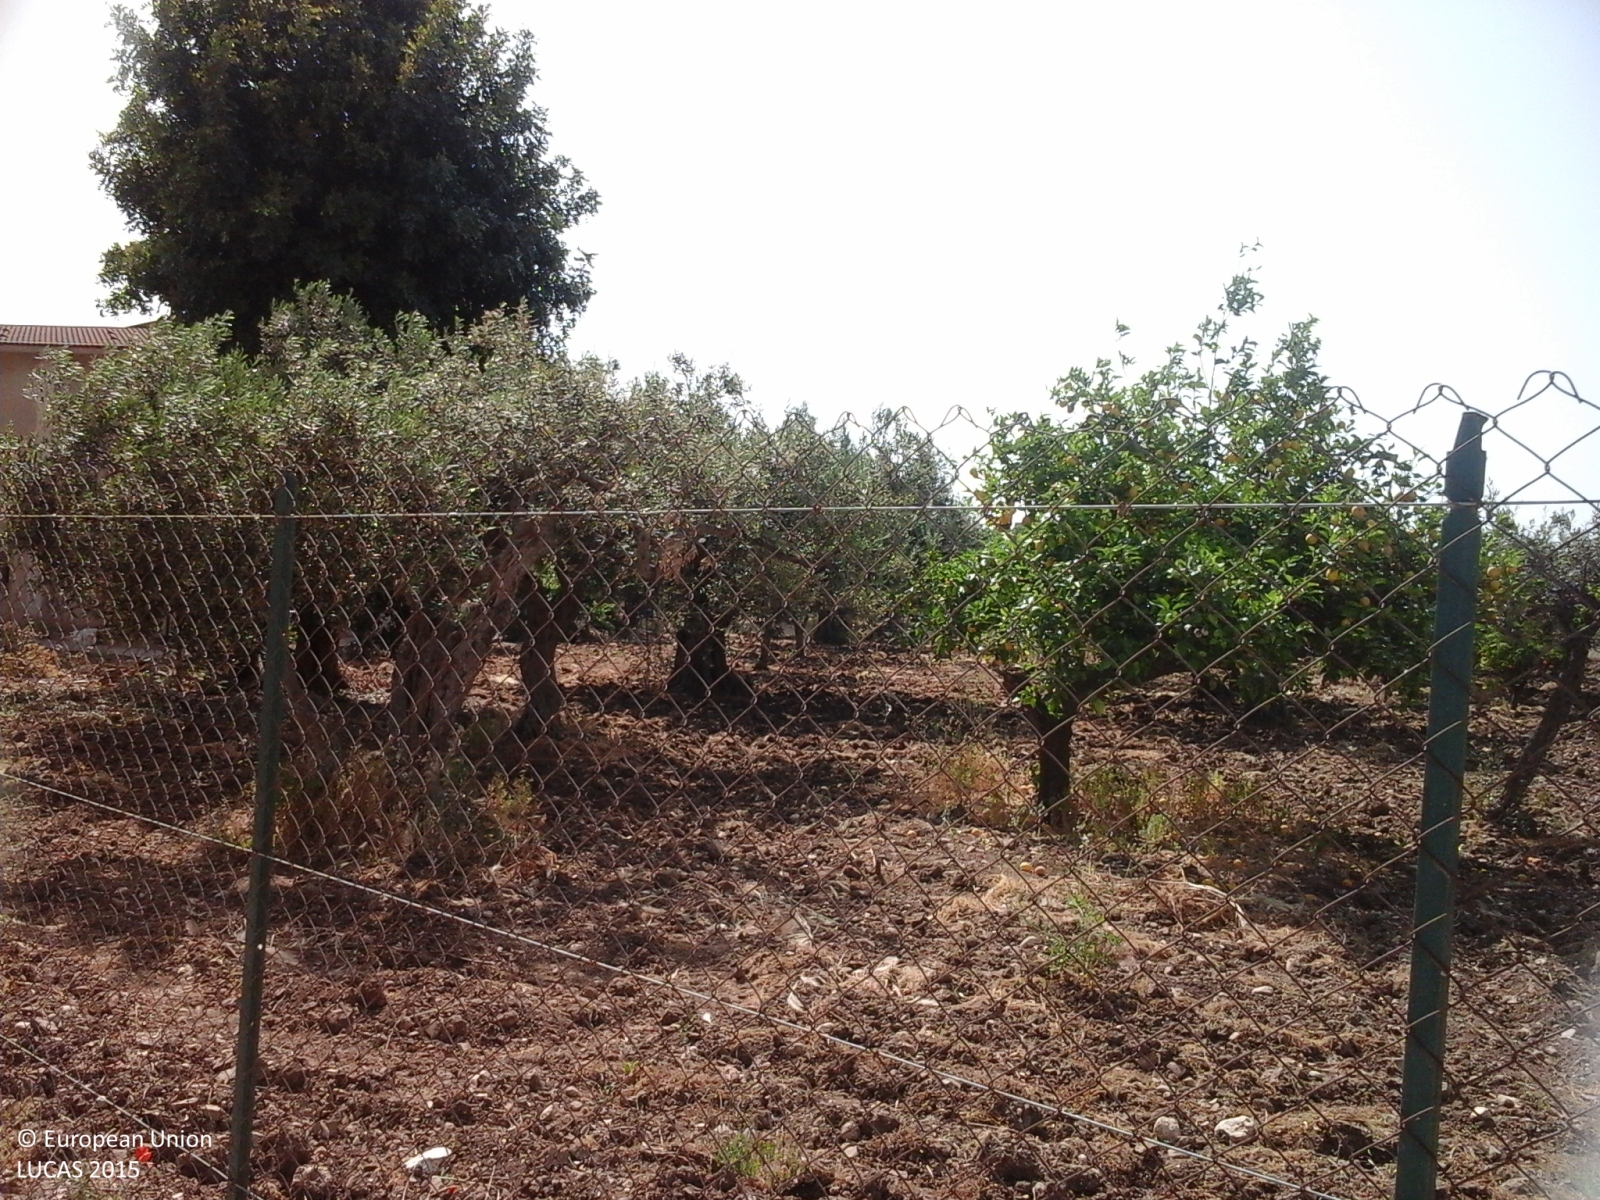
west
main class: Cropland
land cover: Olive groves
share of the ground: 25 - 50 %
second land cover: Other bare soil
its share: > 75 %
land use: Agriculture (excluding fallow land and kitchen gardens)
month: May
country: IT
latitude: 37.5346
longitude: 13.0660
